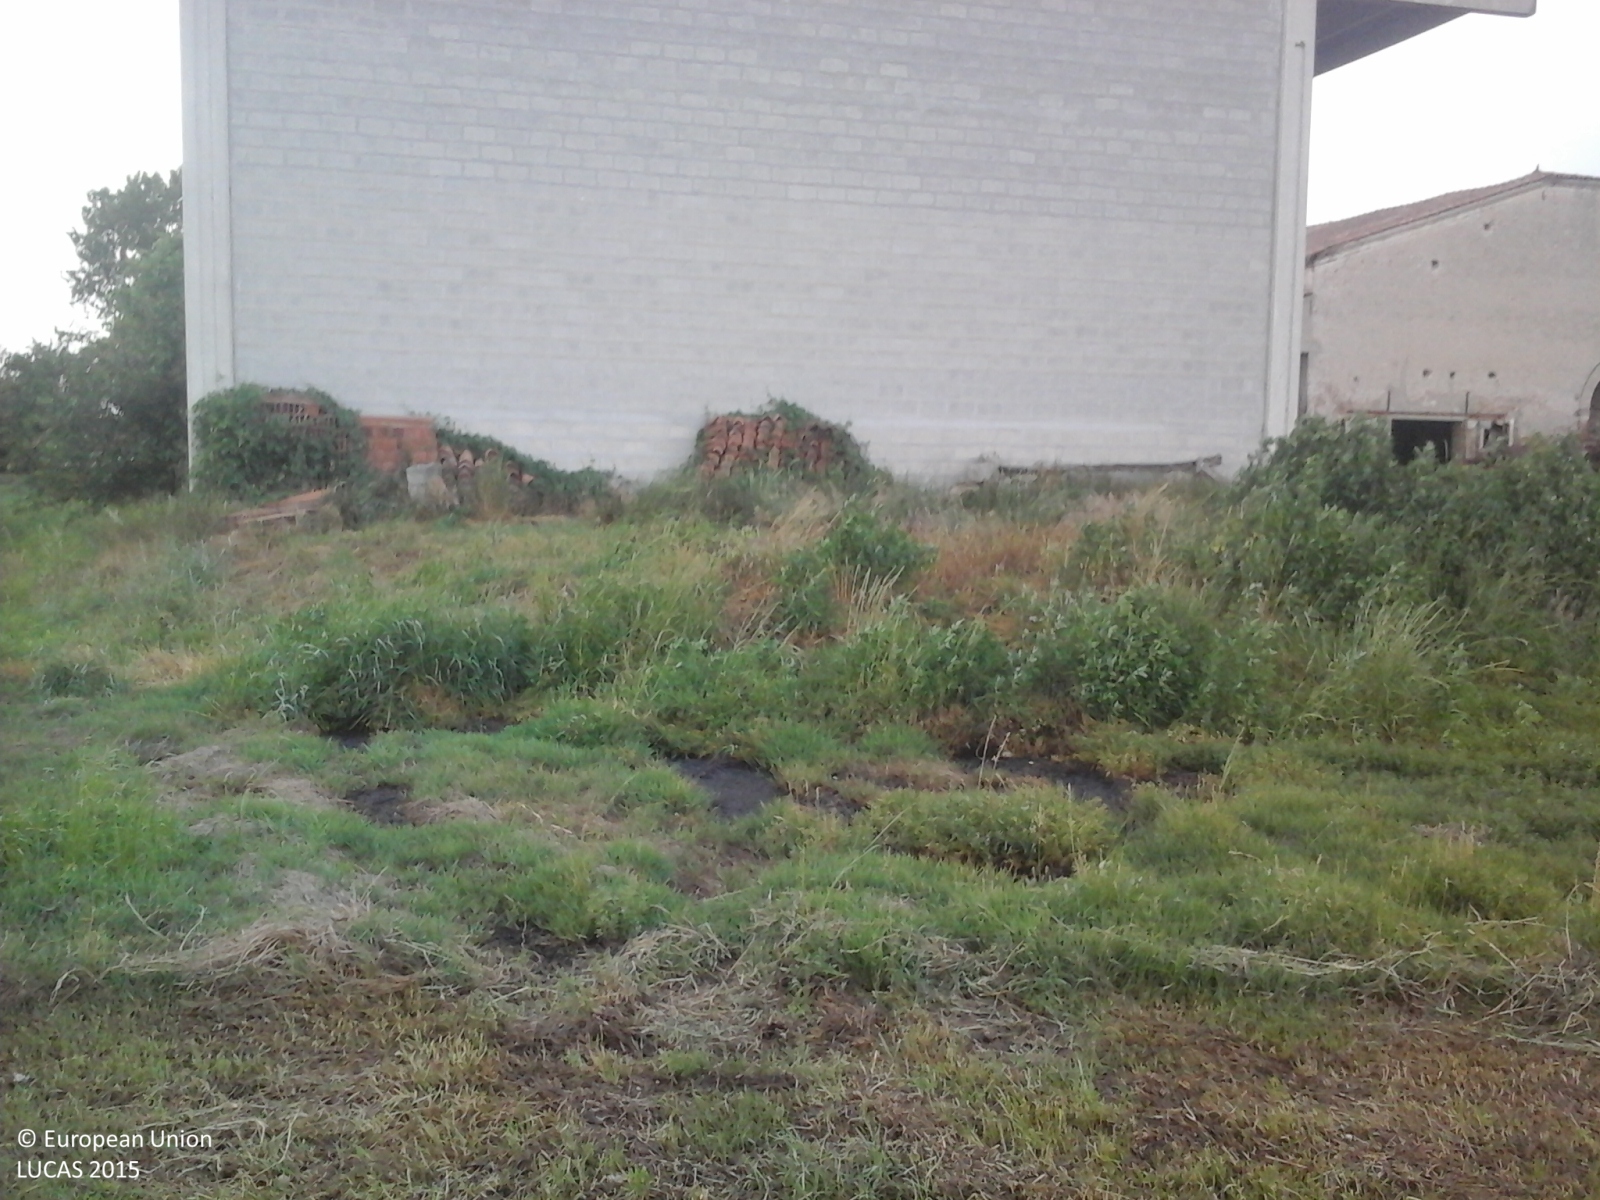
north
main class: Grassland
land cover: Grassland without tree/shrub cover
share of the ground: > 75 %
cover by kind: herbaceous plants 100 %
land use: Agriculture (excluding fallow land and kitchen gardens)
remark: Harvested field
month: May
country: IT
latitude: 45.2137
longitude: 10.6990
